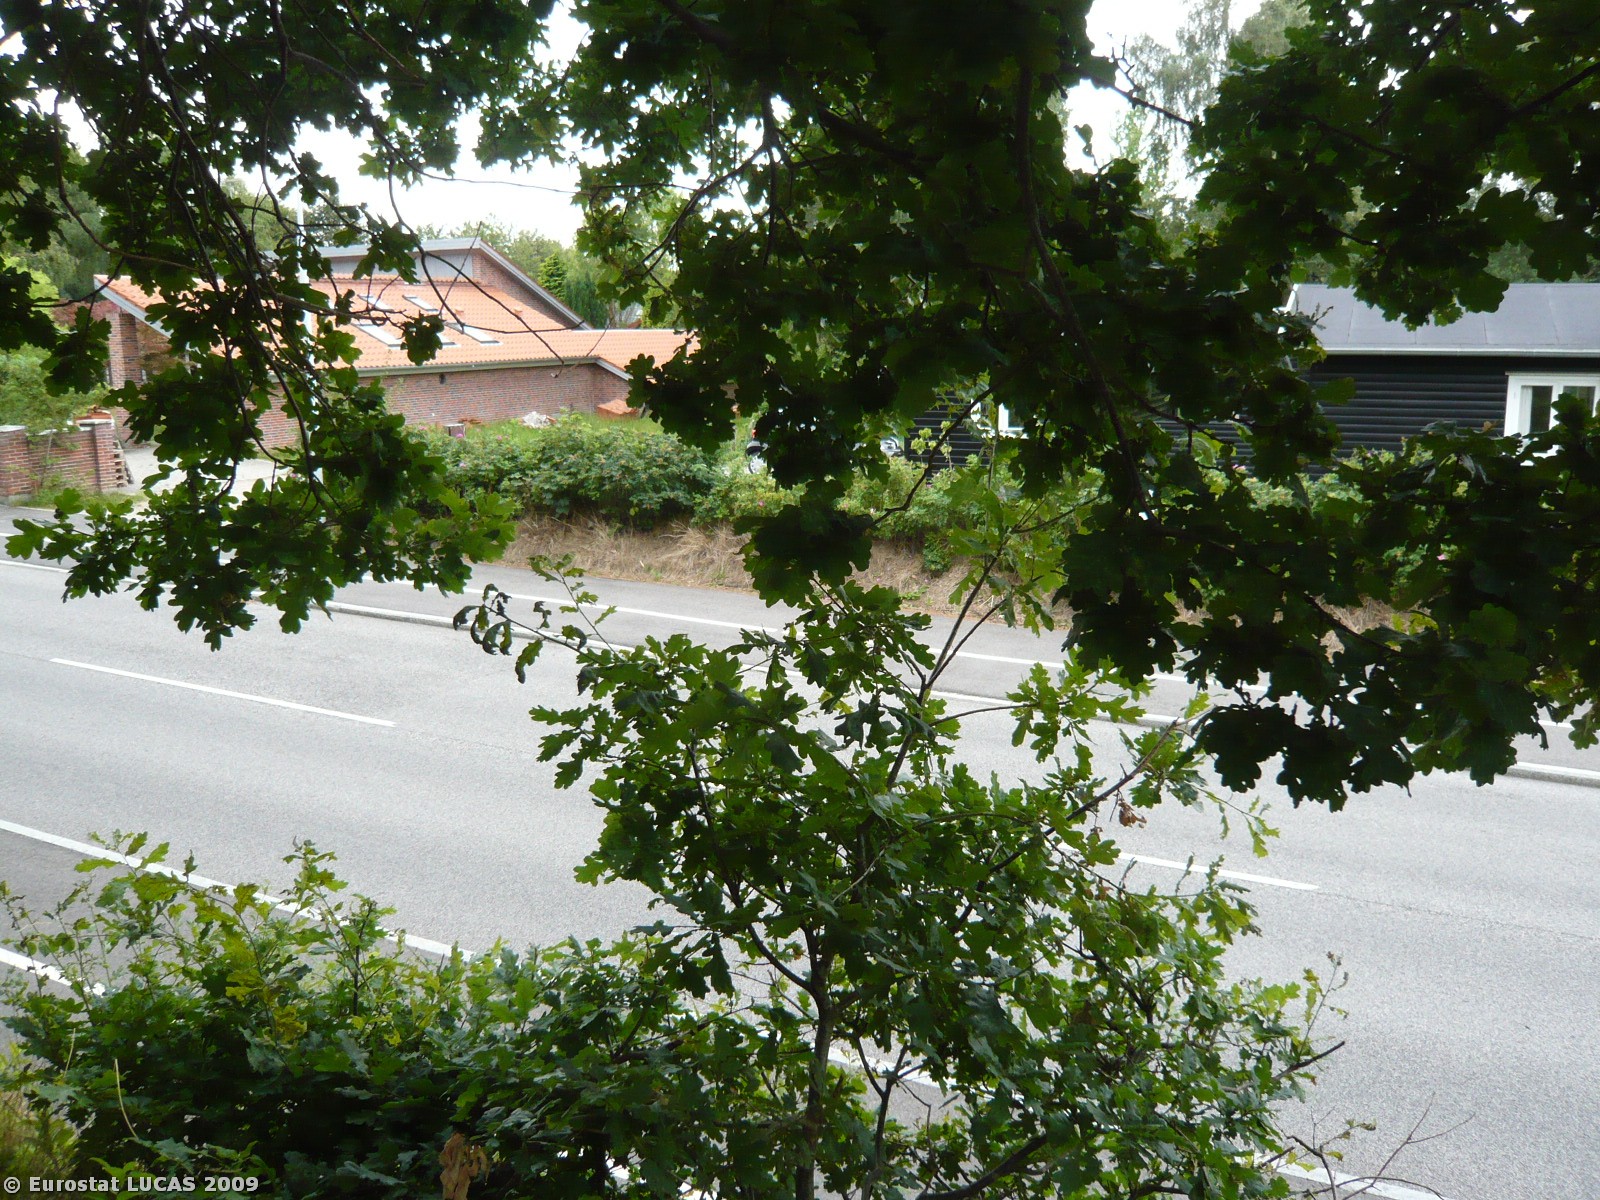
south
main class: Woodland
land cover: Broadleaved woodland
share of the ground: > 75 %
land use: Residential
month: August
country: DK
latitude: 56.0975
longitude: 12.1680
